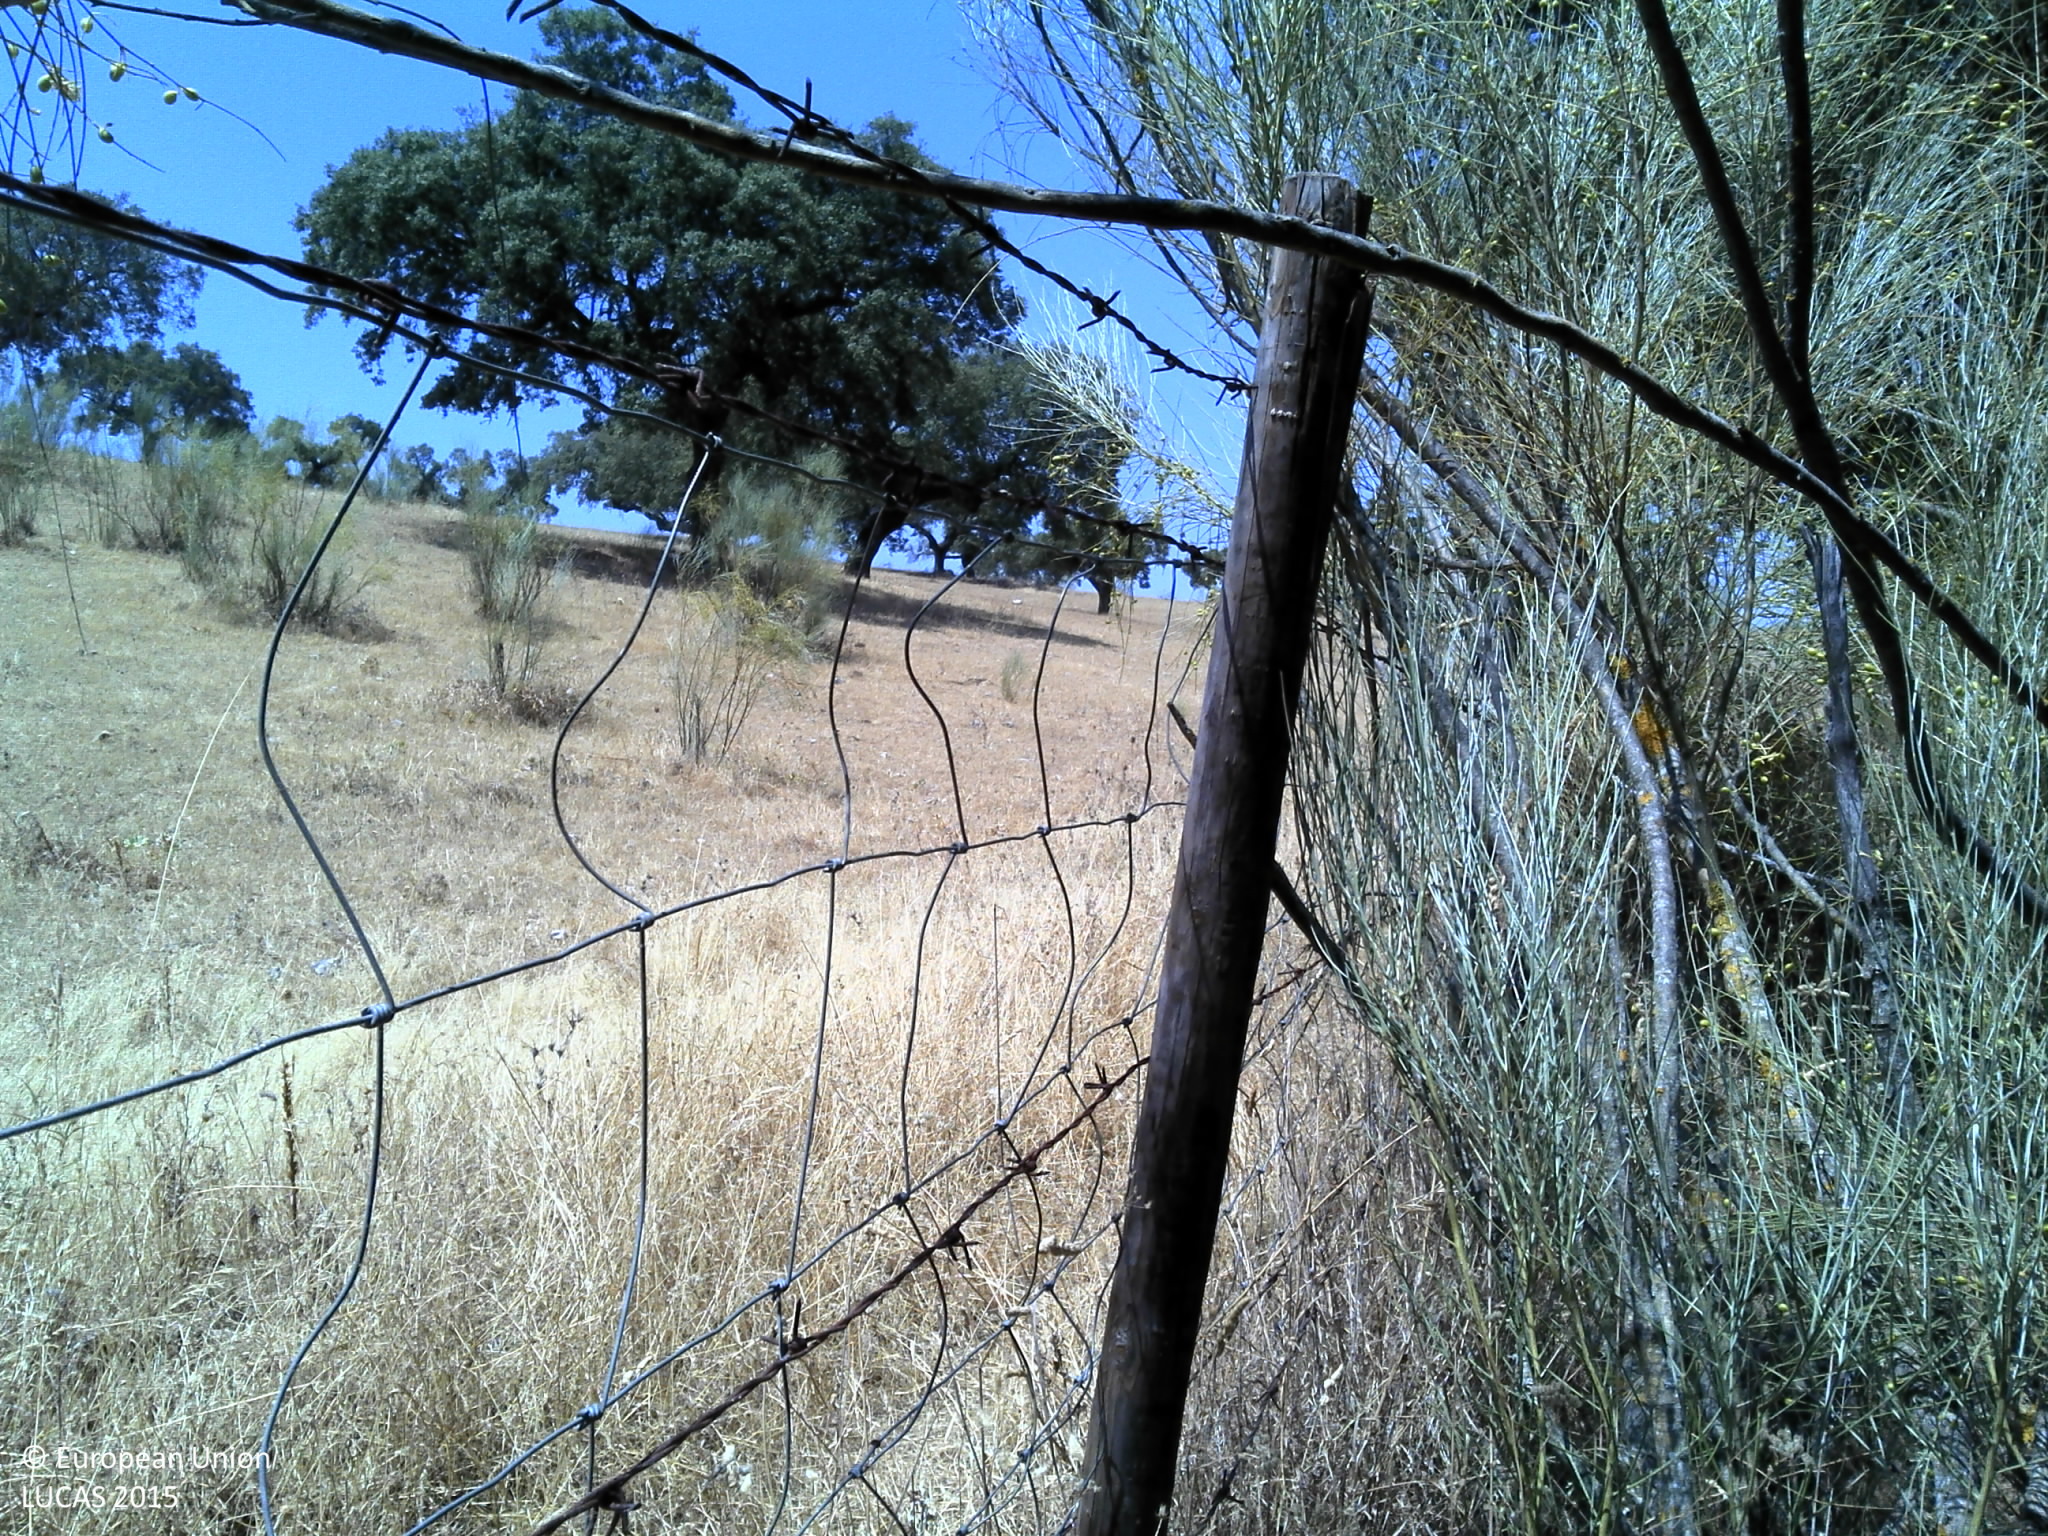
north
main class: Woodland
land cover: Broadleaved woodland
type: broadleaved evergreen forest
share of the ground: 50 - 75 %
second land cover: Grassland without tree/shrub cover
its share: 25 - 50 %
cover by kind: broadleaved forest trees 50 %, herbaceous plants 30 %, unconsolidated bare surface 20 %
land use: Forestry
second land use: Agriculture (excluding fallow land and kitchen gardens)
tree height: > 5 m
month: June
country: PT
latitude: 38.2105
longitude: -7.3450
